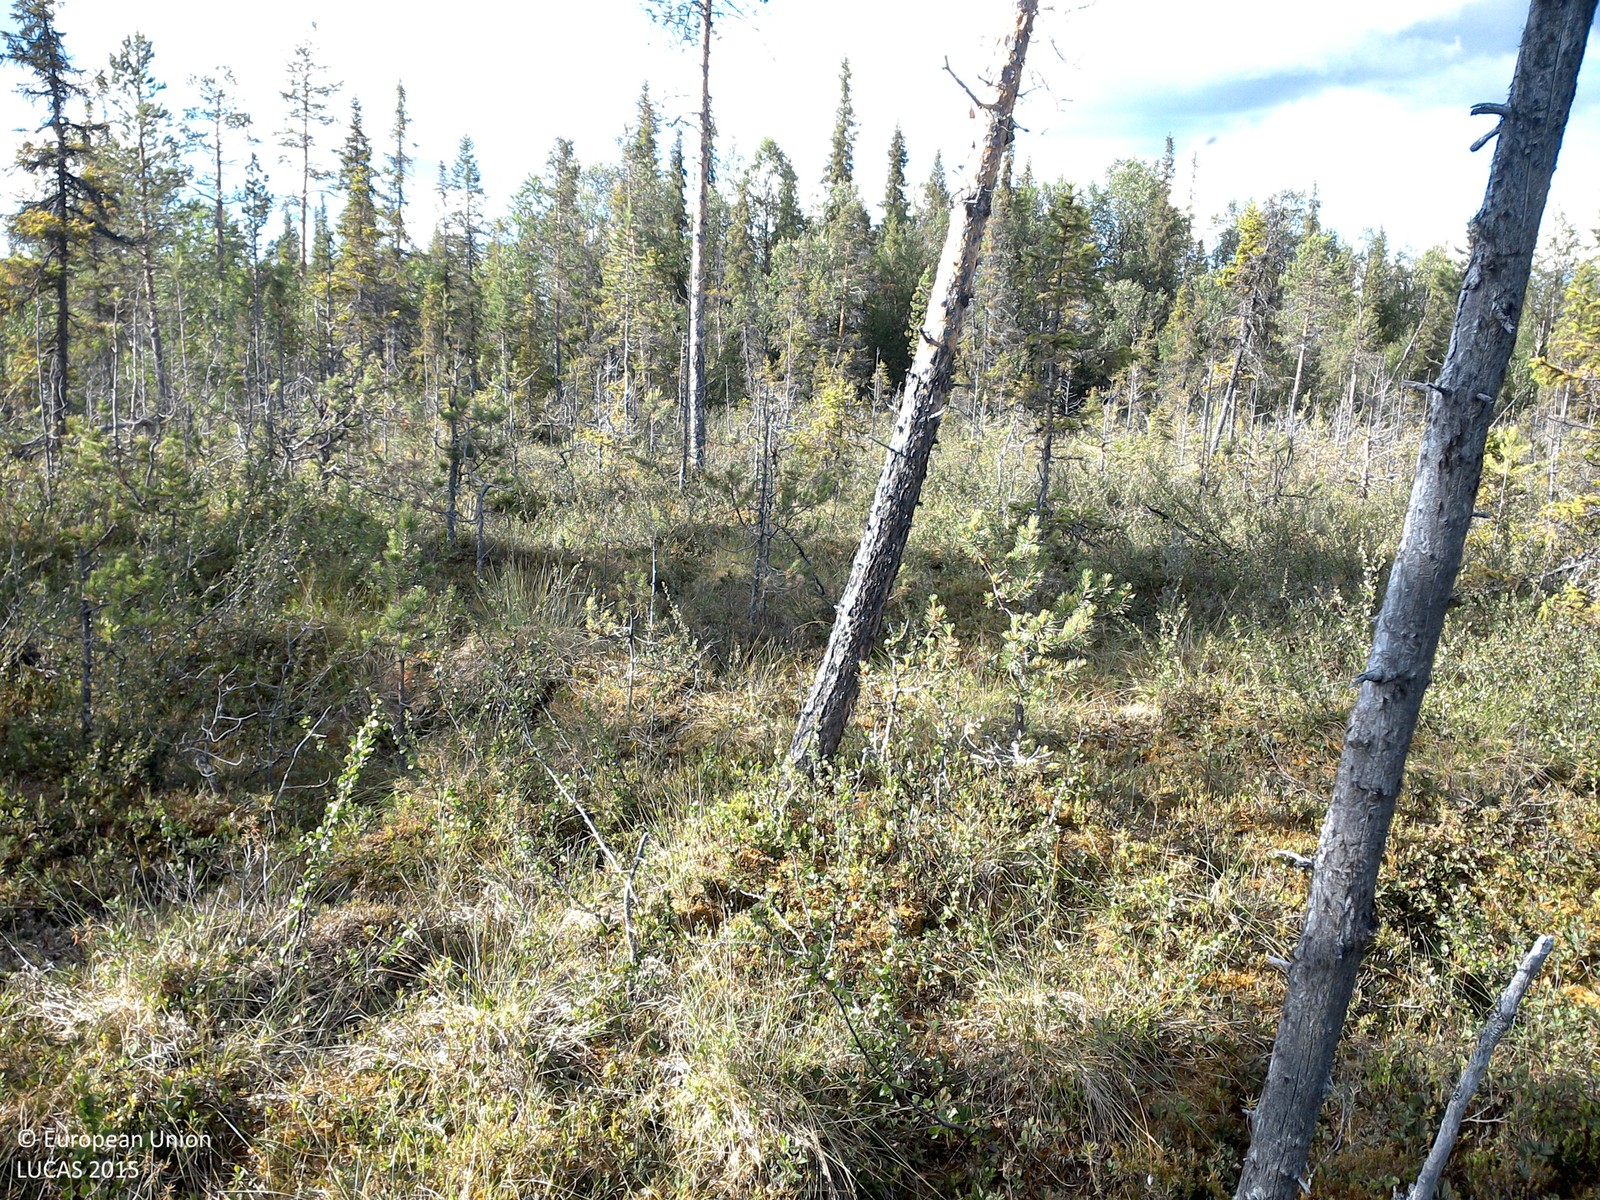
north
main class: Woodland
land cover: Pine dominated coniferous woodland
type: boreal forest
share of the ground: 10 - 25 %
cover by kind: shrubs 75 %, coniferous forest trees 15 %, lichens and mosses 10 %
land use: Semi-natural and natural areas not in use
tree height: > 5 m
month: July
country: SE
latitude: 67.7224
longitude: 21.1251
